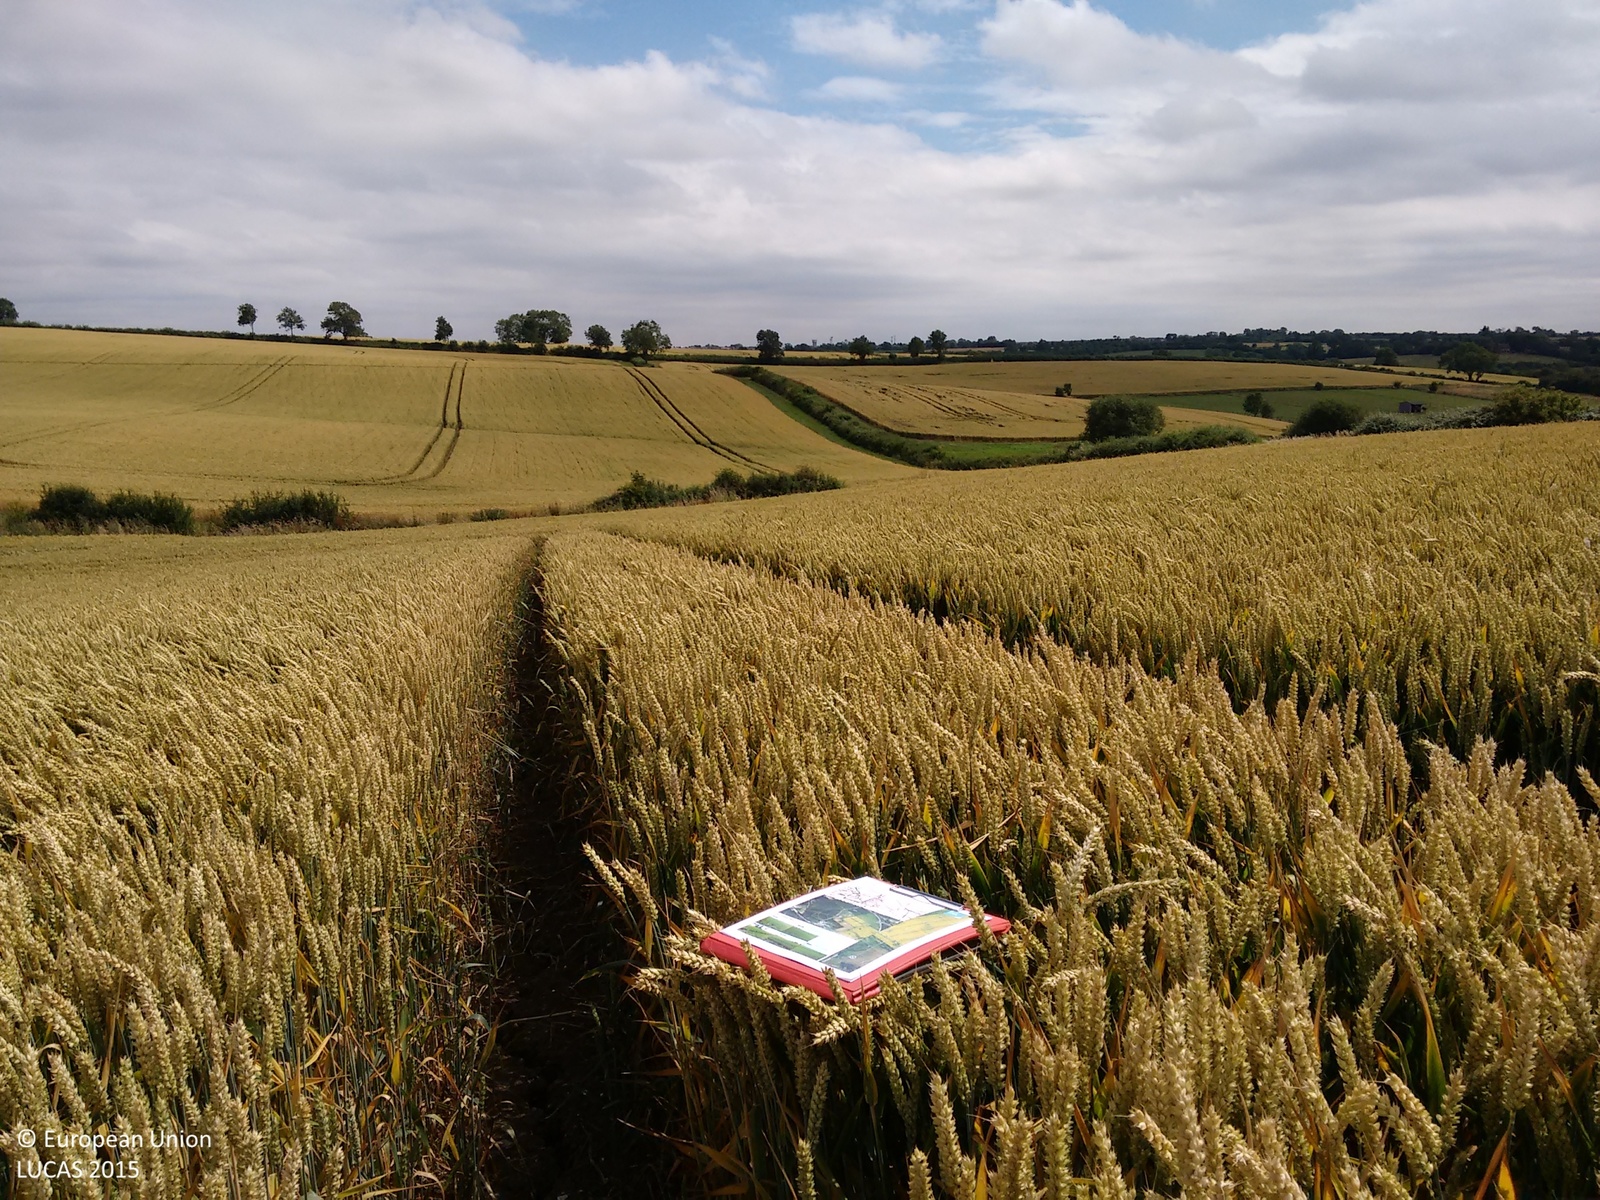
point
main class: Cropland
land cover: Common wheat
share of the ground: > 75 %
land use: Agriculture (excluding fallow land and kitchen gardens)
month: July
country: GB
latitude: 52.4584
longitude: -0.8593
